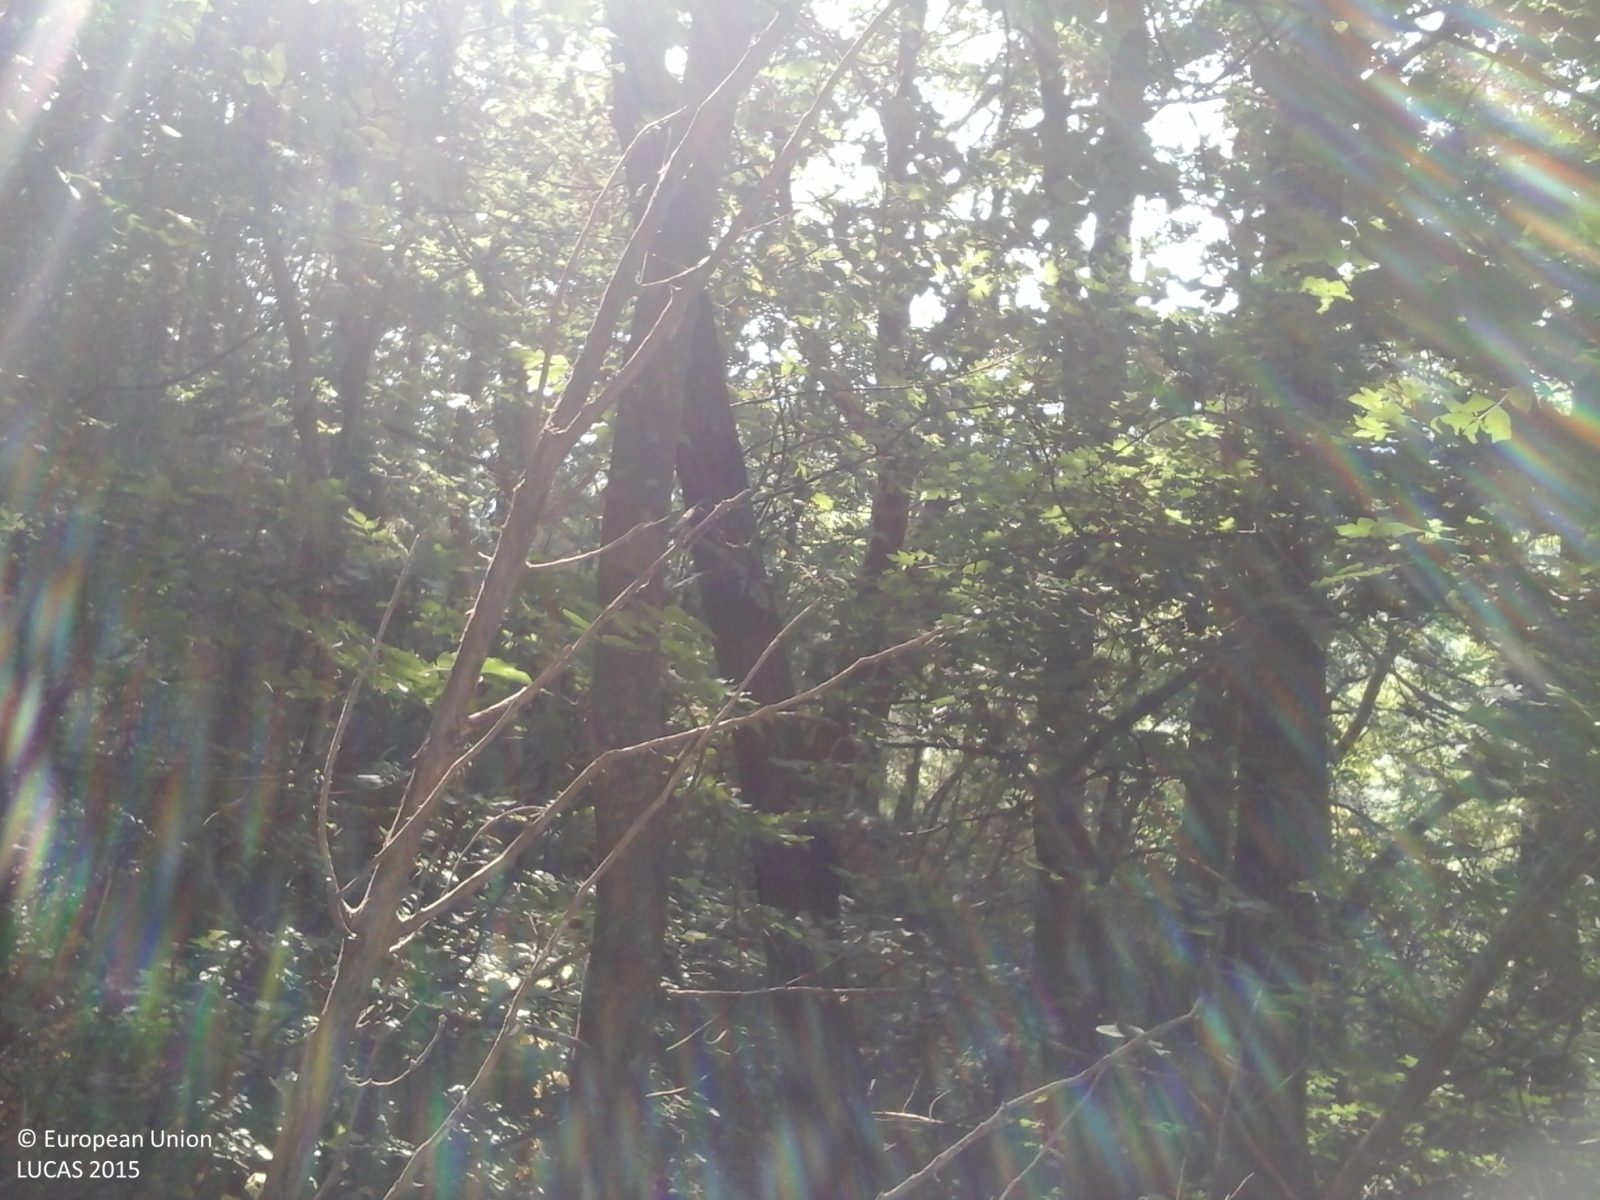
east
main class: Woodland
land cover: Broadleaved woodland
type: thermophilous deciduous forest
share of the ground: > 75 %
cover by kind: broadleaved forest trees 100 %
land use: Forestry
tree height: > 5 m
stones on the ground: < 10 %
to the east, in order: Broadleaved woodland; Tracks; Broadleaved woodland
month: July
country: IT
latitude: 44.4405
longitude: 10.2382
